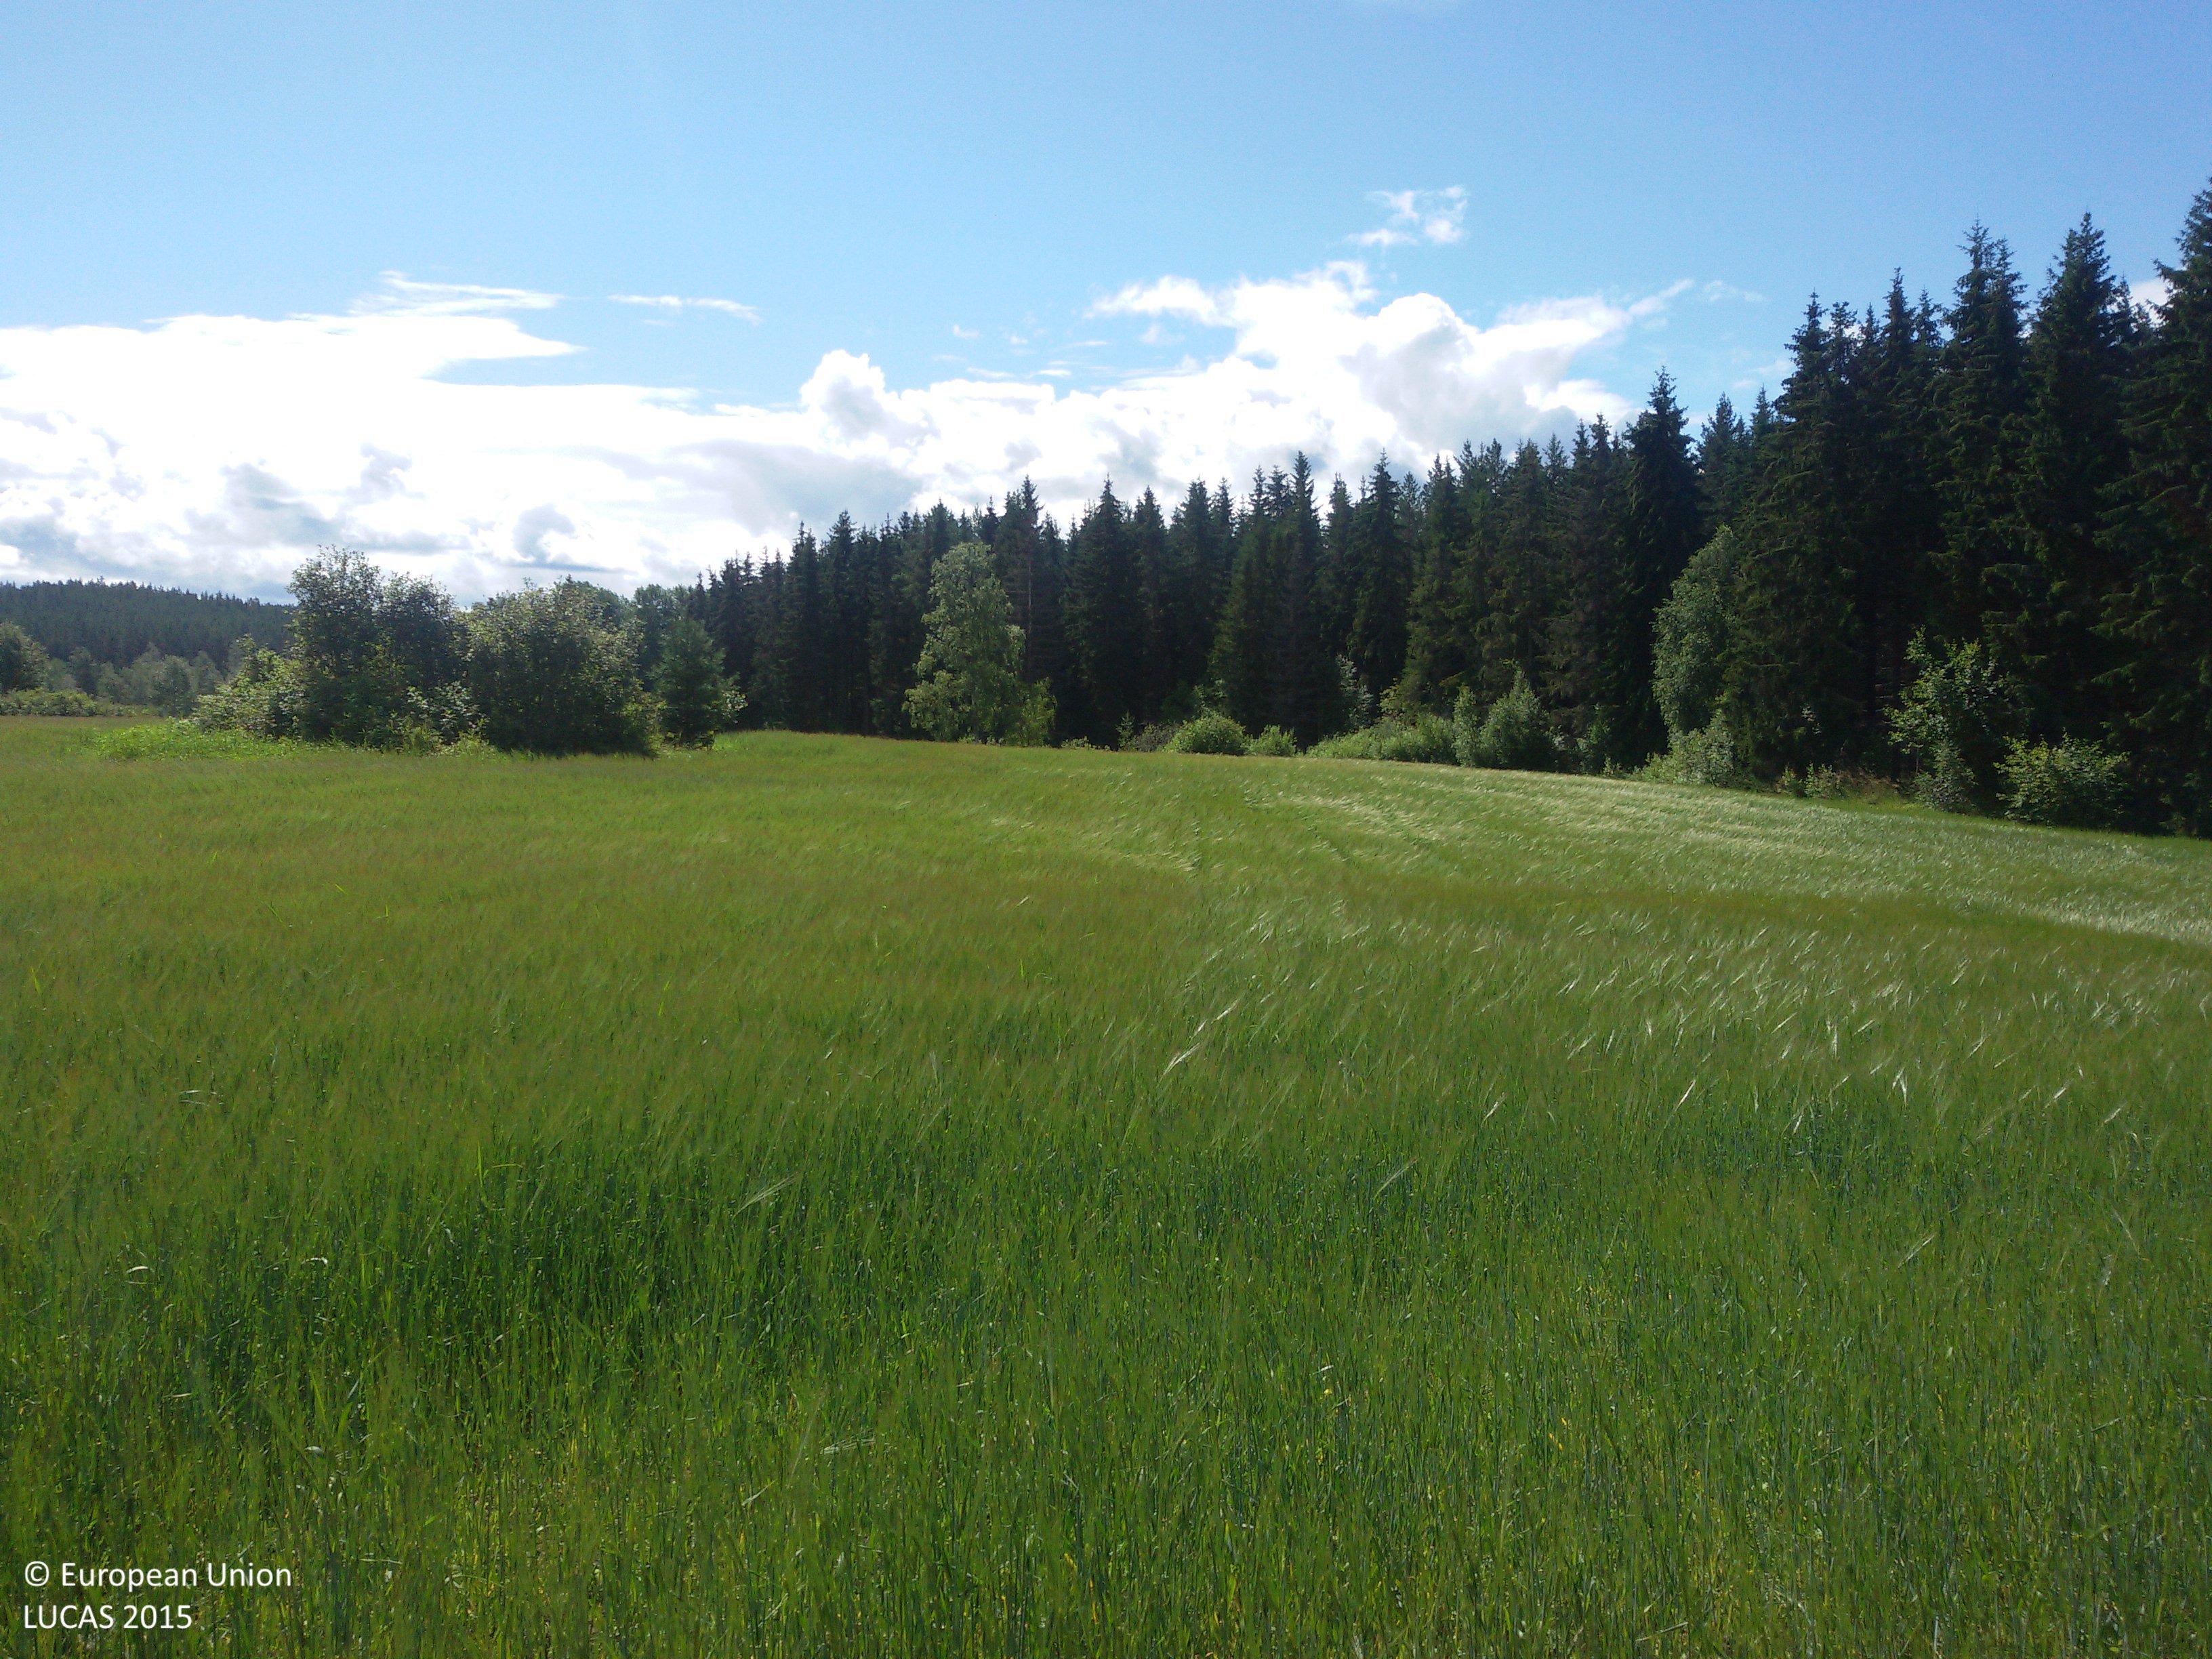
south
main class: Cropland
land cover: Barley
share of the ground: > 75 %
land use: Agriculture (excluding fallow land and kitchen gardens)
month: July
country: SE
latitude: 60.4756
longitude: 15.8275
